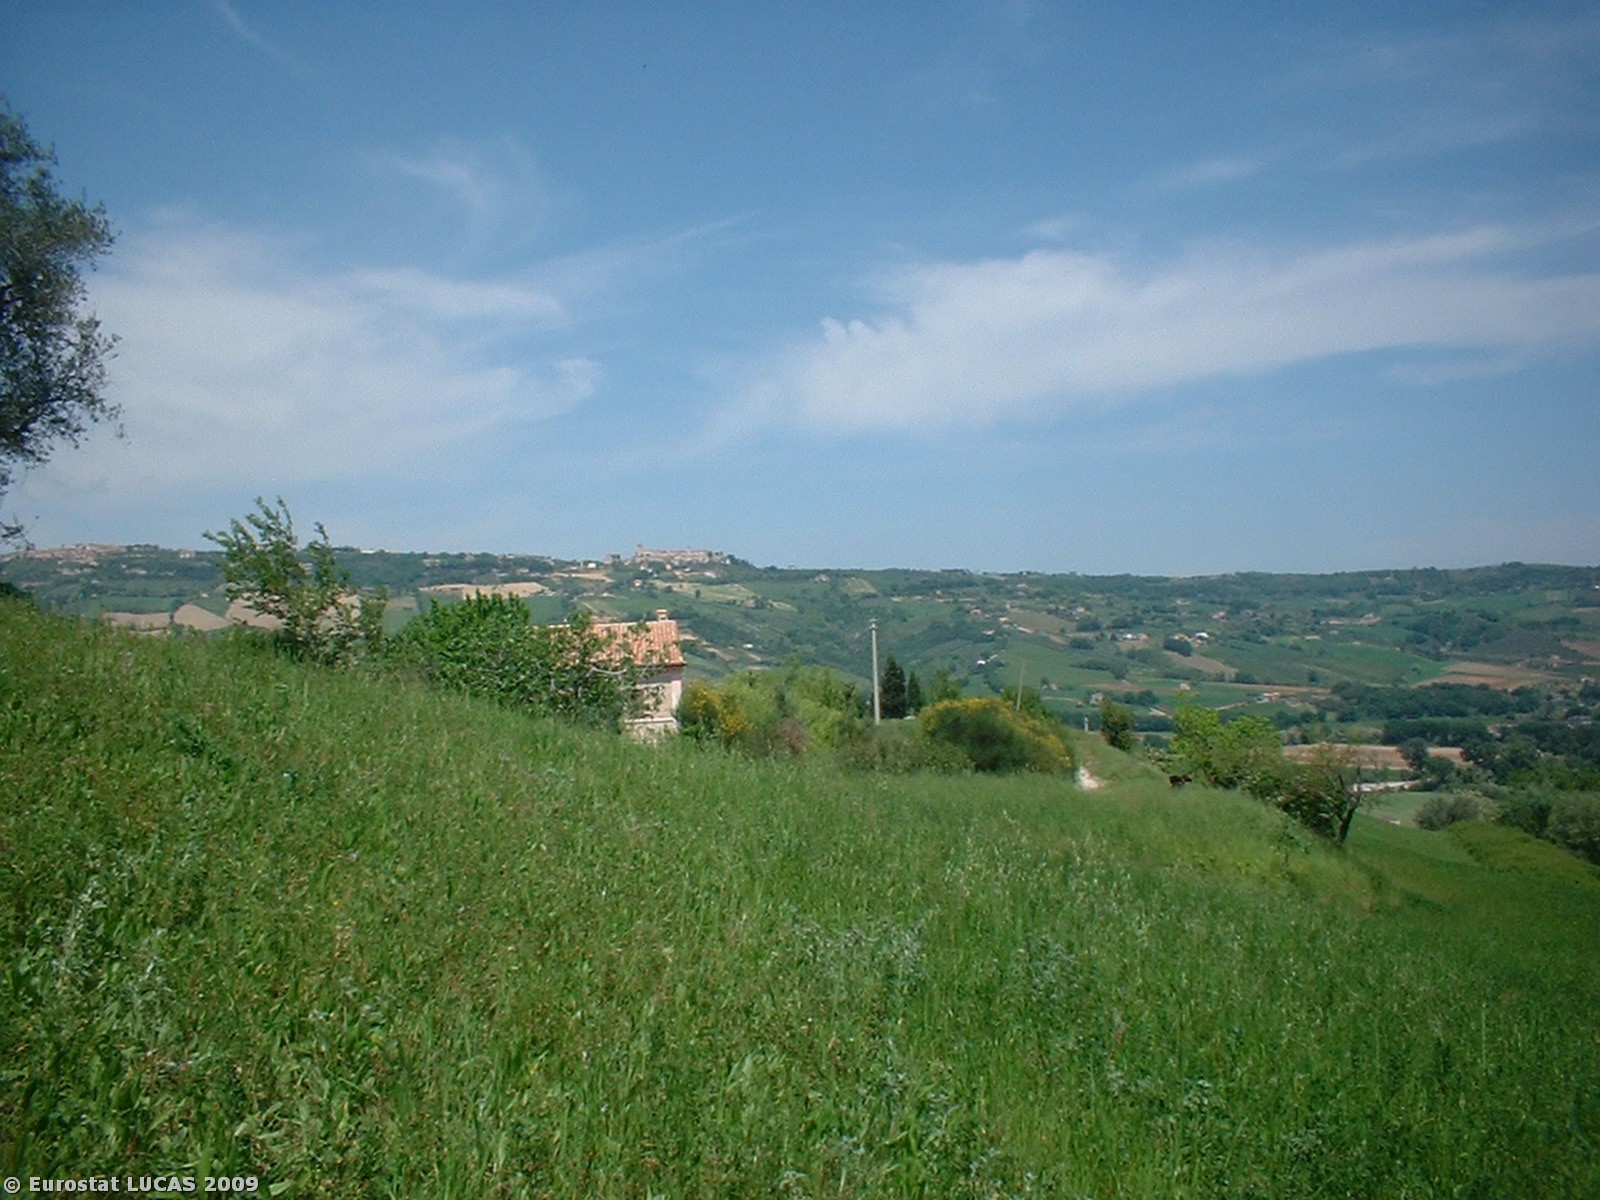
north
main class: Cropland
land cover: Olive groves
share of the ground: 10 - 25 %
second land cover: Grassland with sparse tree/shrub cover
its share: > 75 %
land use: Agriculture (excluding fallow land and kitchen gardens)
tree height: < 5 m
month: May
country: IT
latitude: 43.0551
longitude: 13.7348
